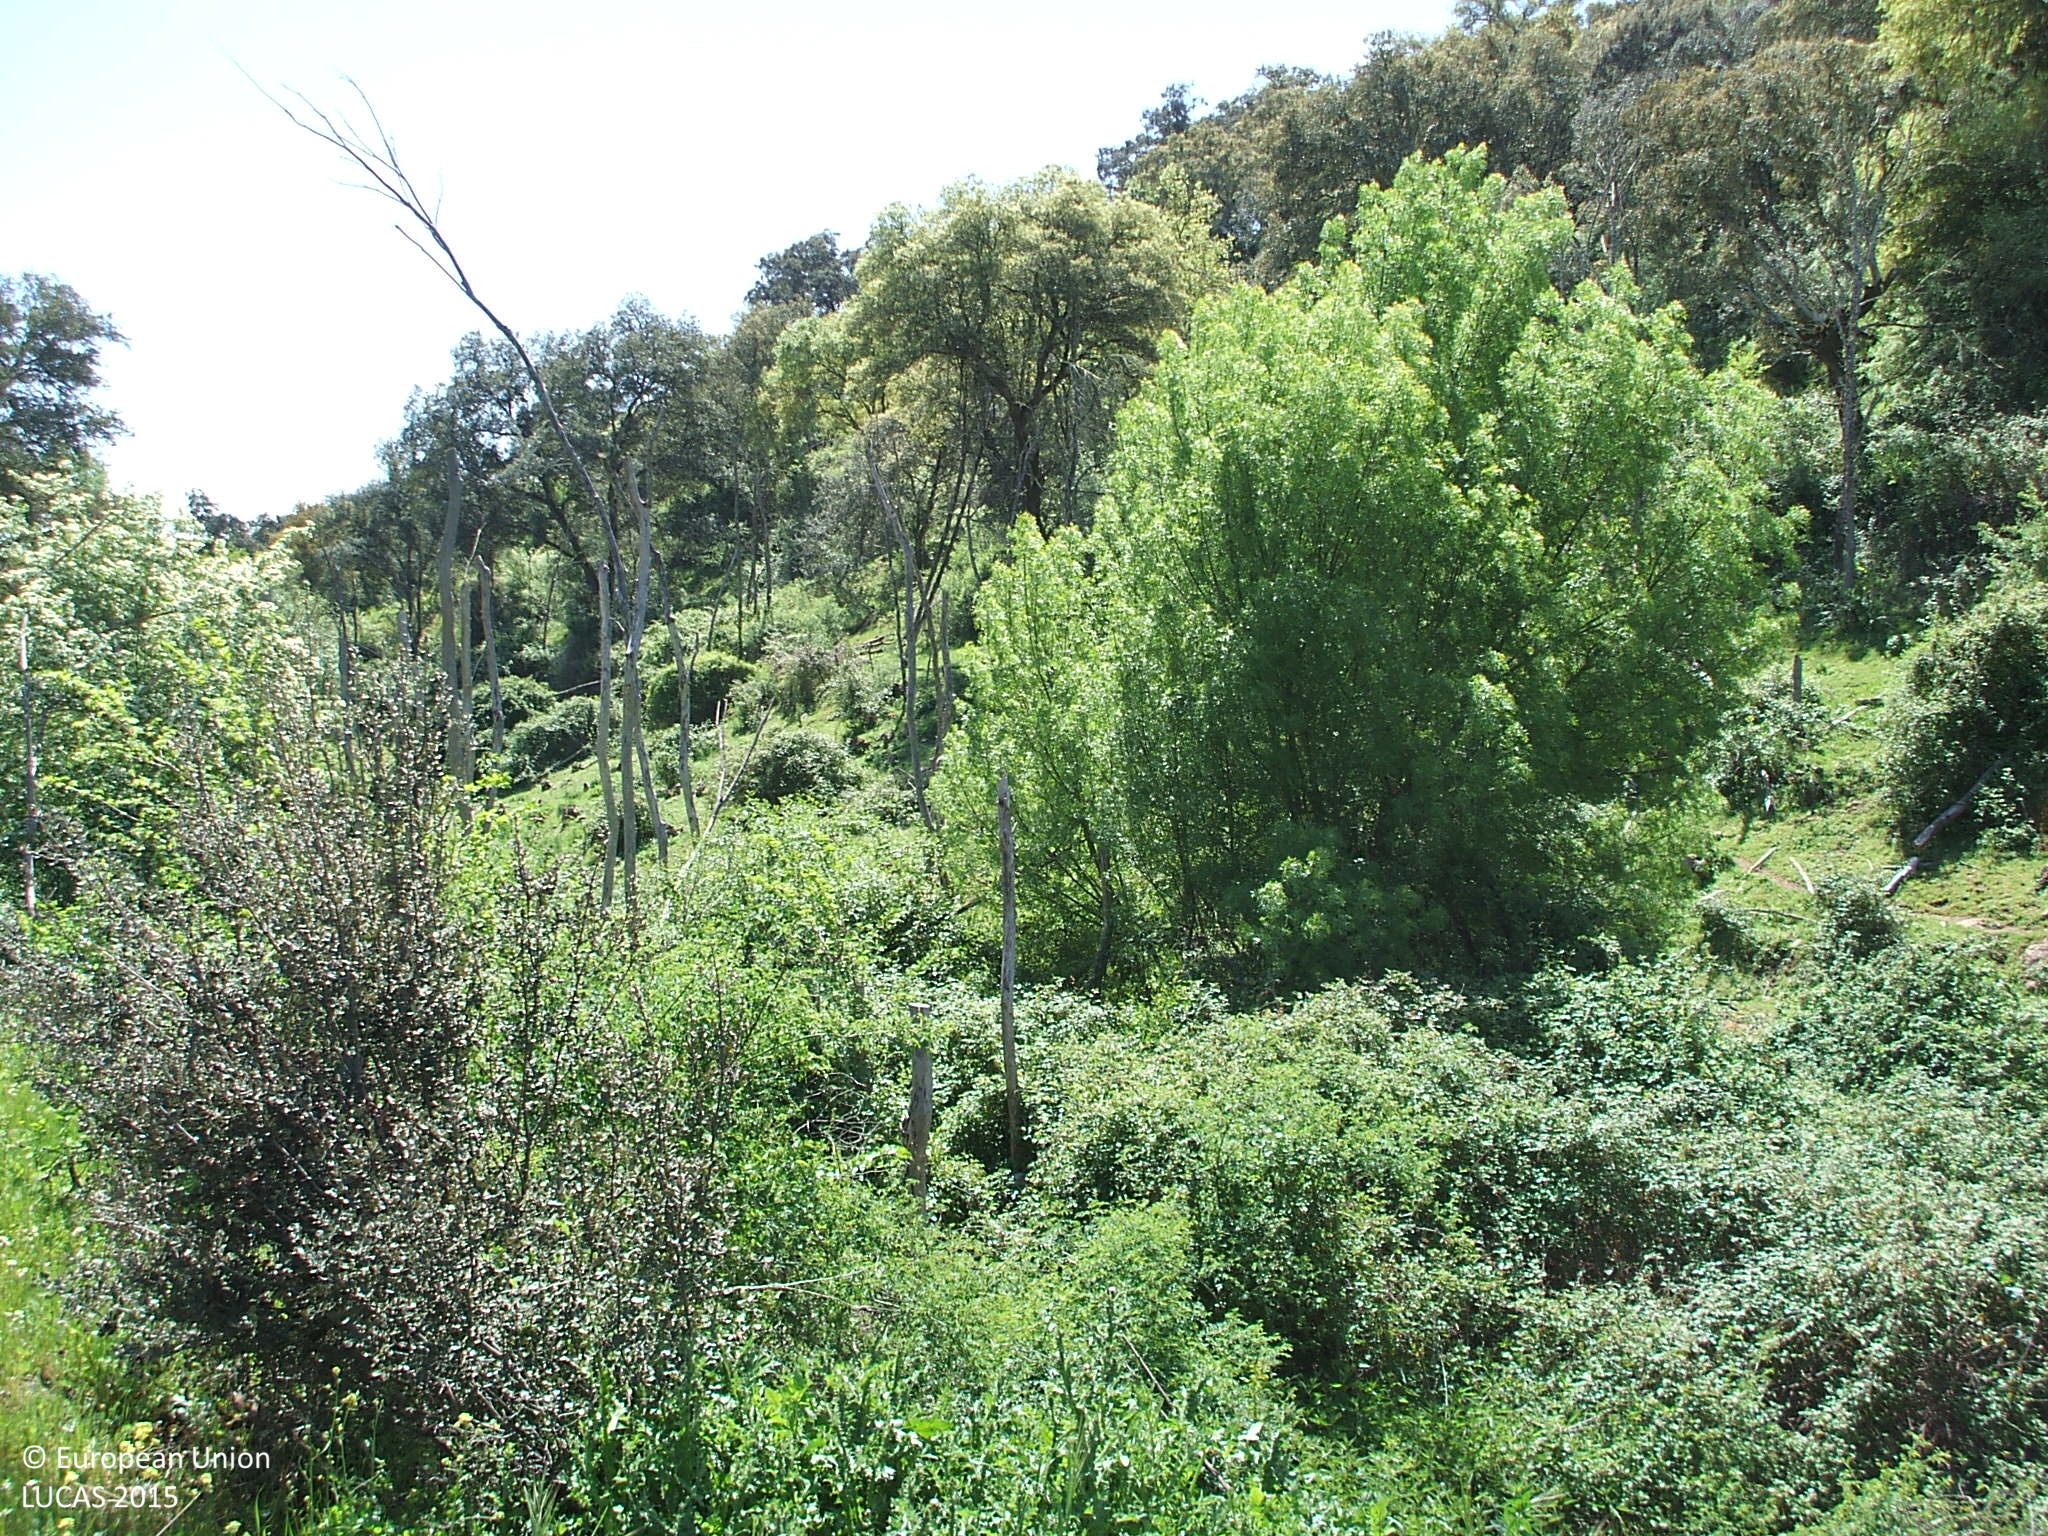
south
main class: Shrubland
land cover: Shrubland with sparse tree cover
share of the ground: > 75 %
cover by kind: shrubs 70 %, herbaceous plants 25 %, broadleaved forest trees 5 %
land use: Agriculture (excluding fallow land and kitchen gardens)
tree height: > 5 m
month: April
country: ES
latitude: 37.9279
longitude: -5.6946
